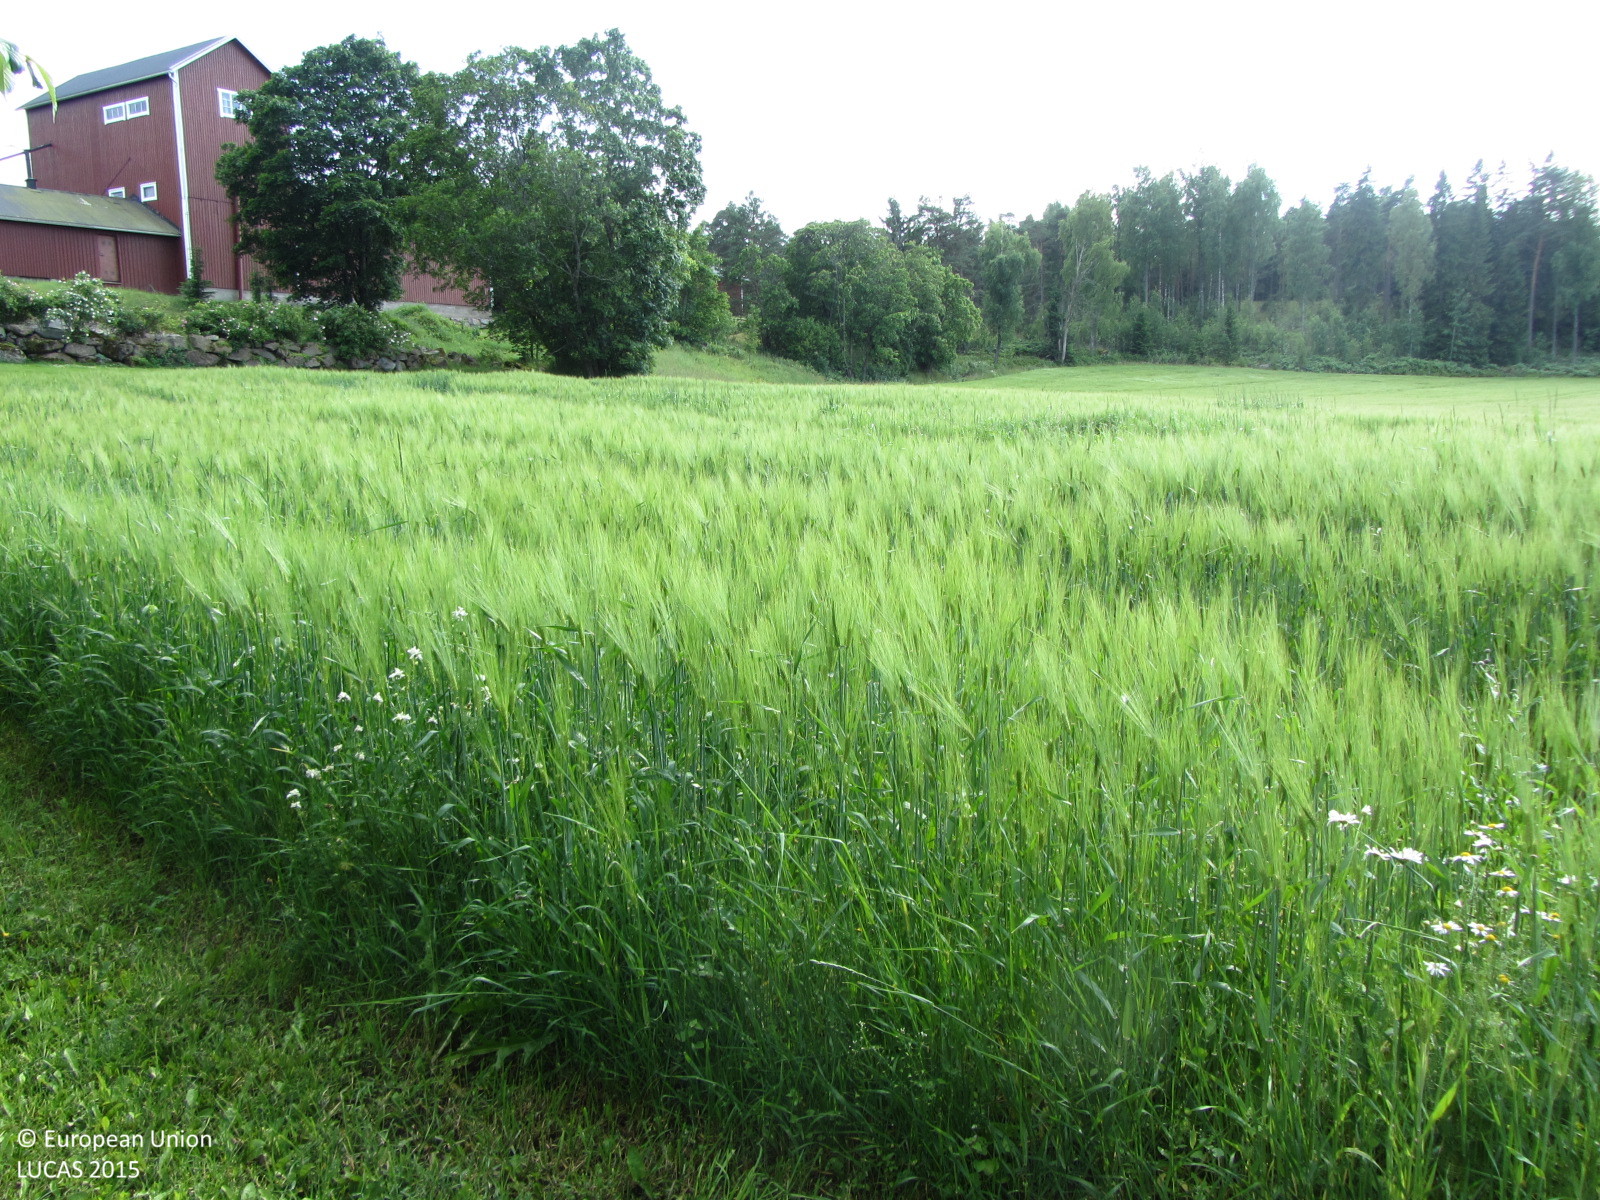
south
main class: Grassland
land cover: Grassland without tree/shrub cover
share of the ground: > 75 %
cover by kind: herbaceous plants 100 %
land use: Residential
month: July
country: FI
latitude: 60.0400
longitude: 24.4154
